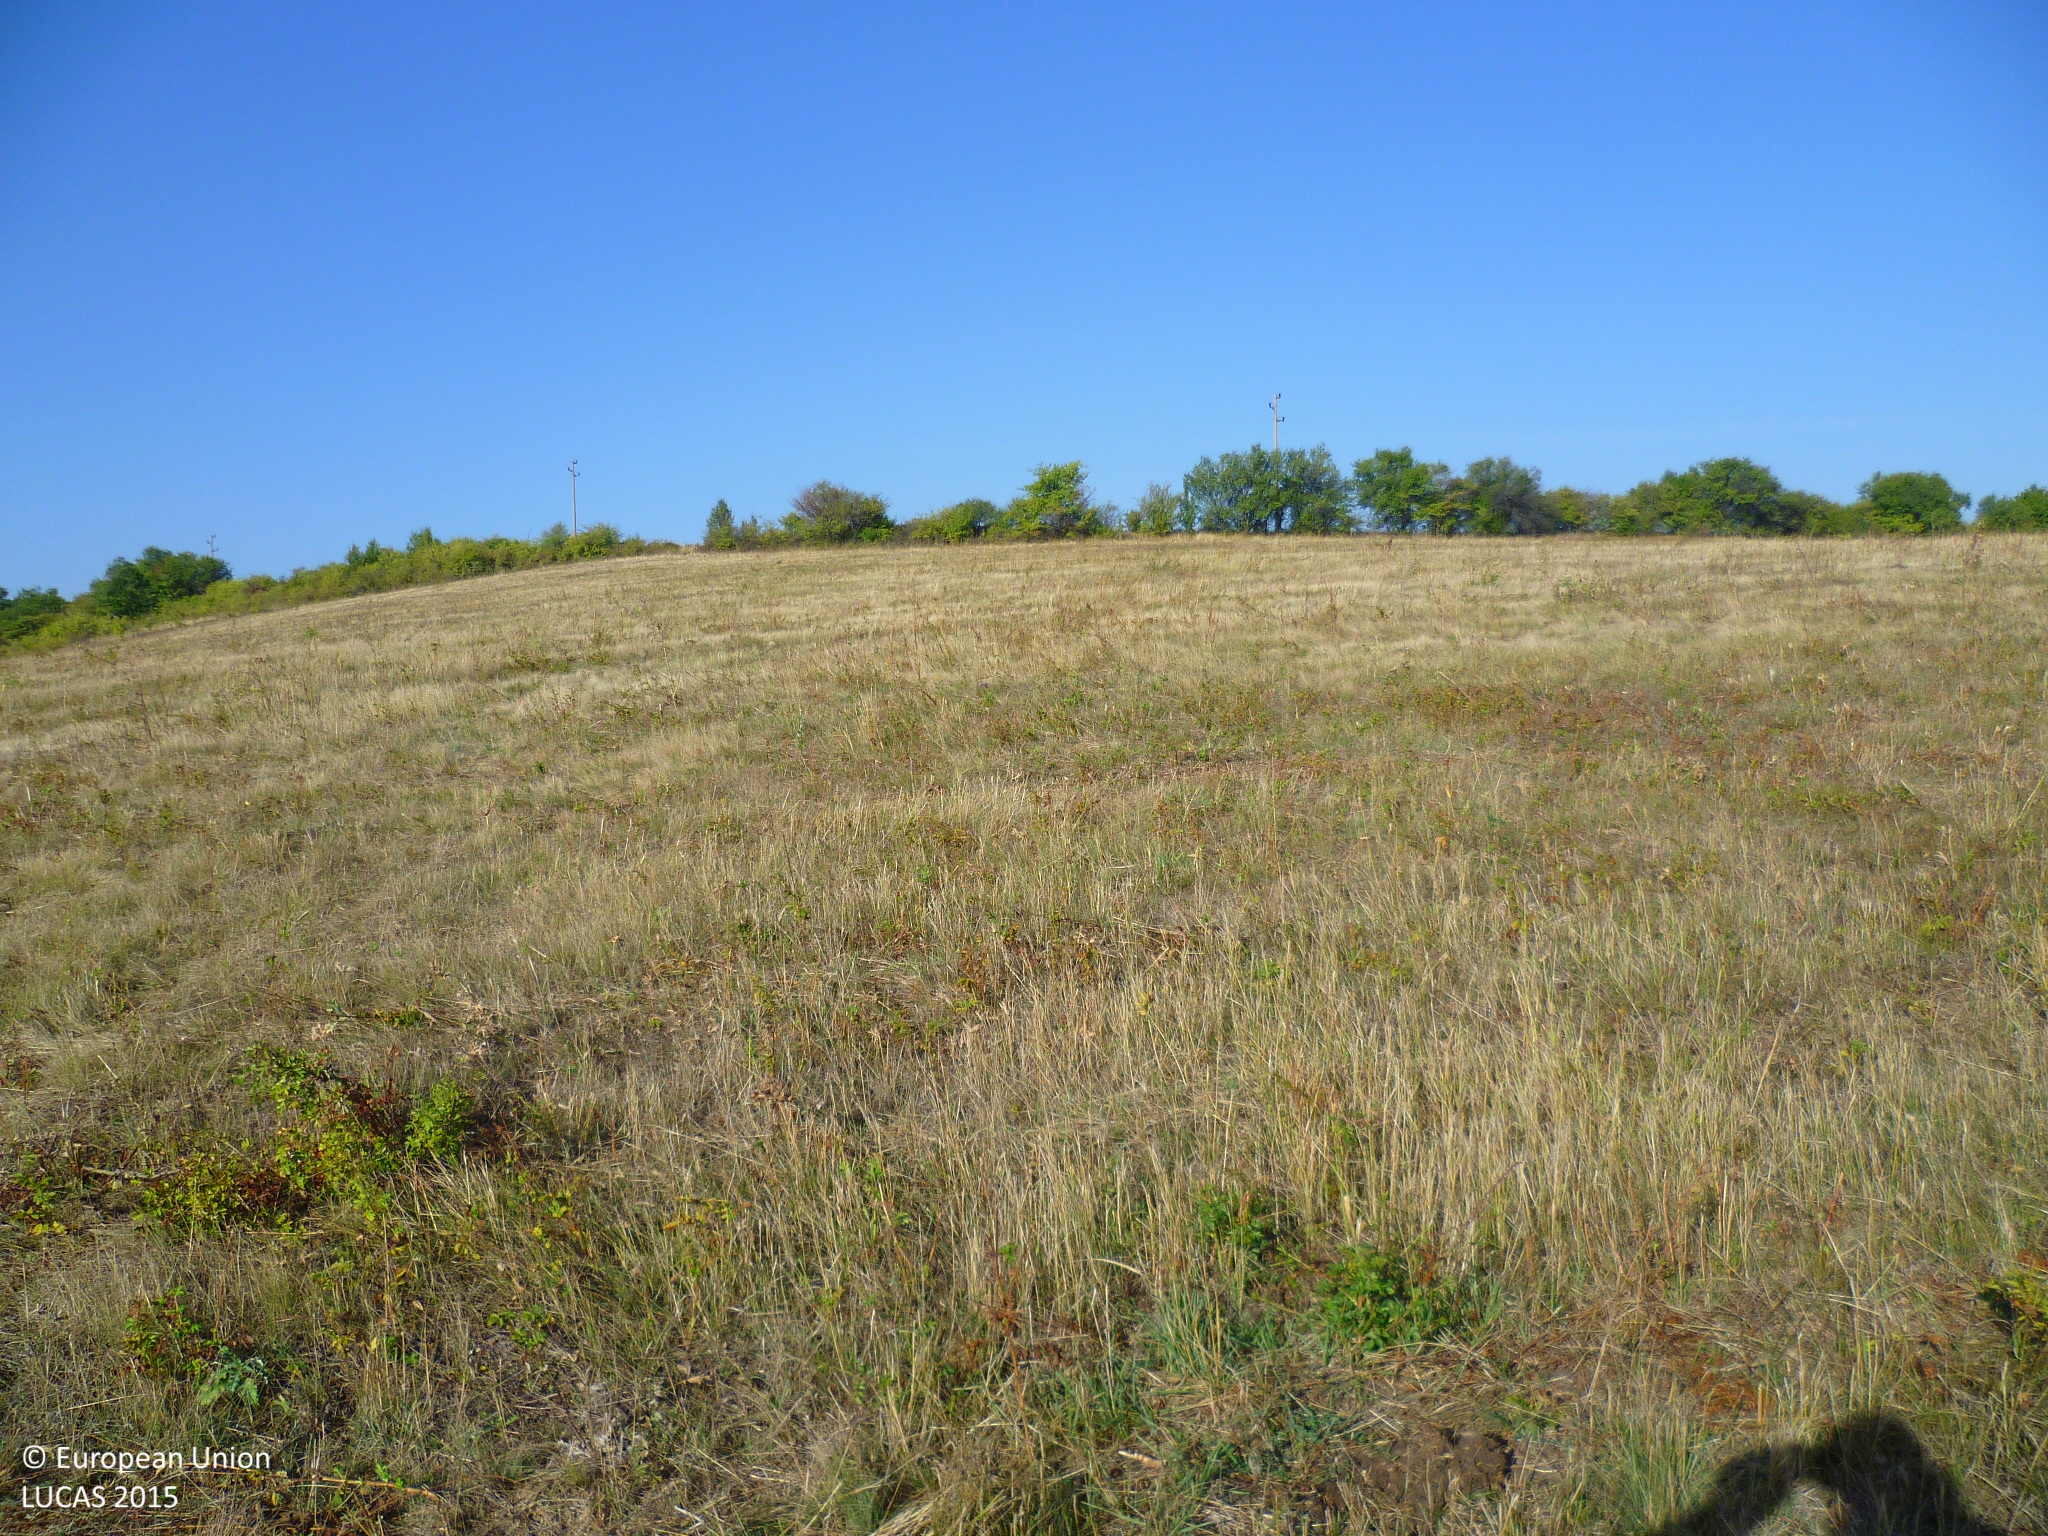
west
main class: Grassland
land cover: Grassland without tree/shrub cover
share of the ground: > 75 %
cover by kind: herbaceous plants 100 %
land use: Agriculture (excluding fallow land and kitchen gardens)
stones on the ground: < 10 %
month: September
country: BG
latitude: 42.7533
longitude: 23.0678
